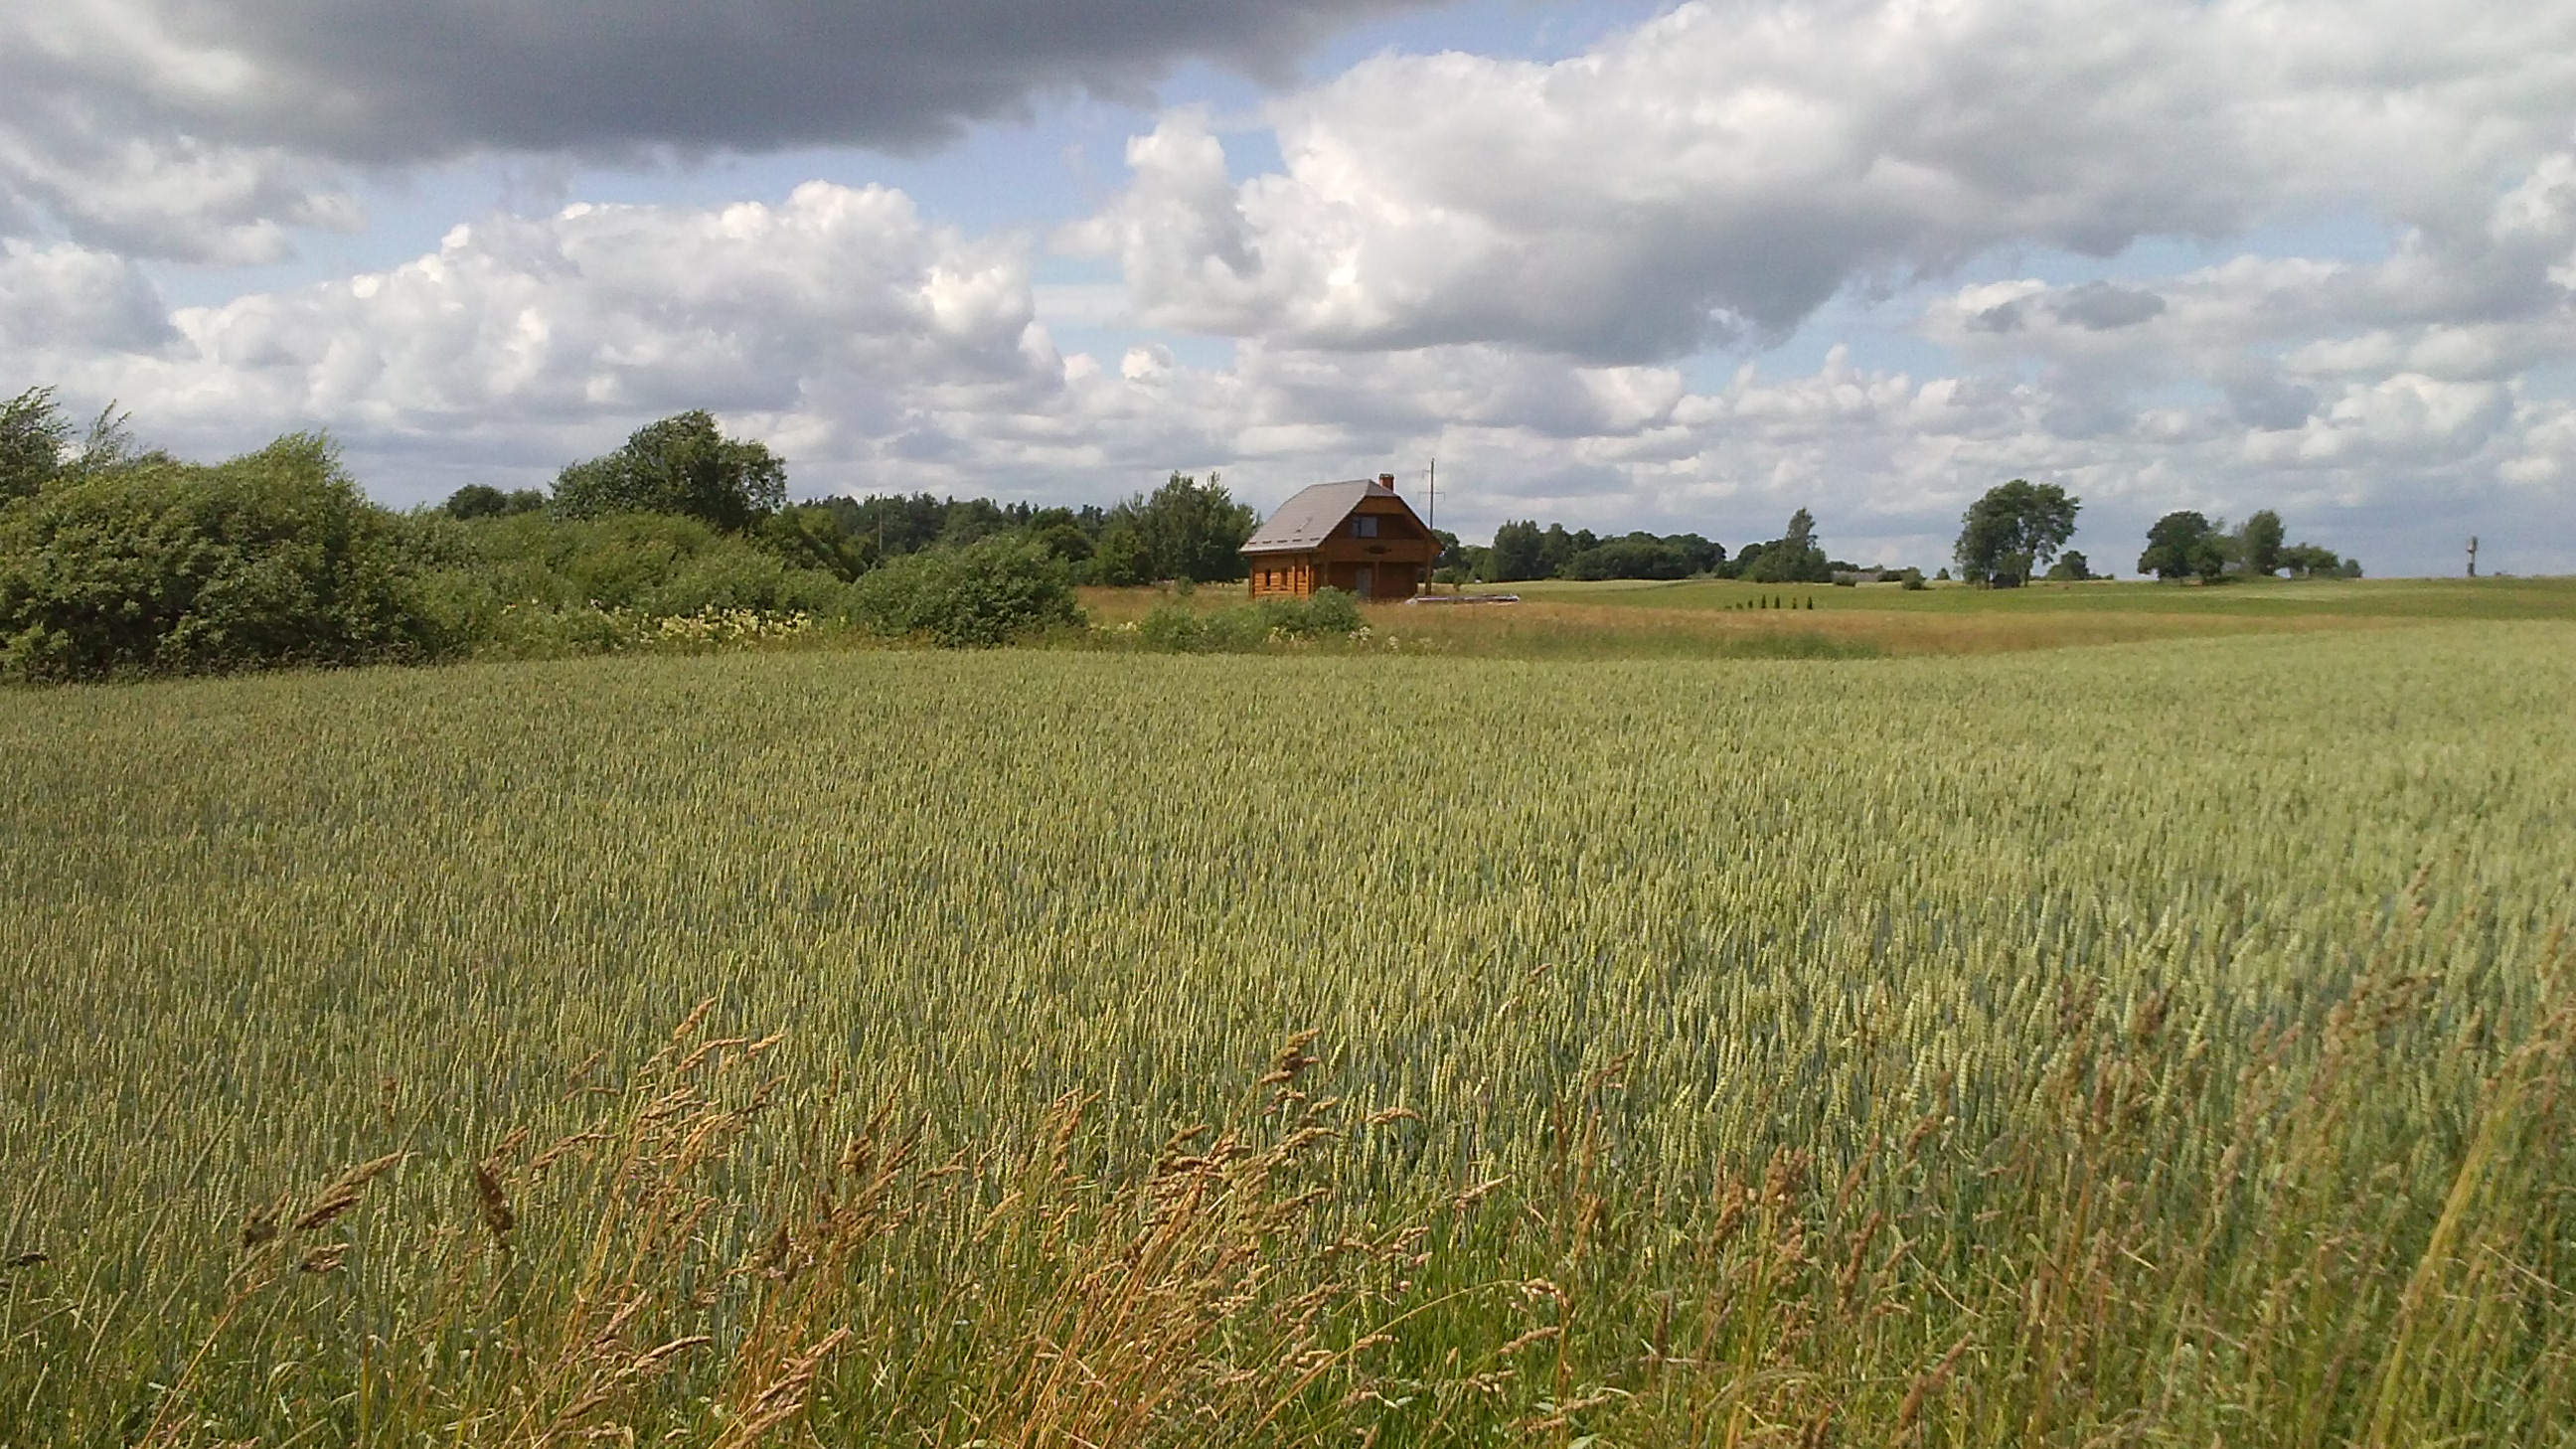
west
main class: Cropland
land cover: Common wheat
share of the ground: > 75 %
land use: Agriculture (excluding fallow land and kitchen gardens)
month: July
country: LV
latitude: 56.4866
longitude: 26.9367
